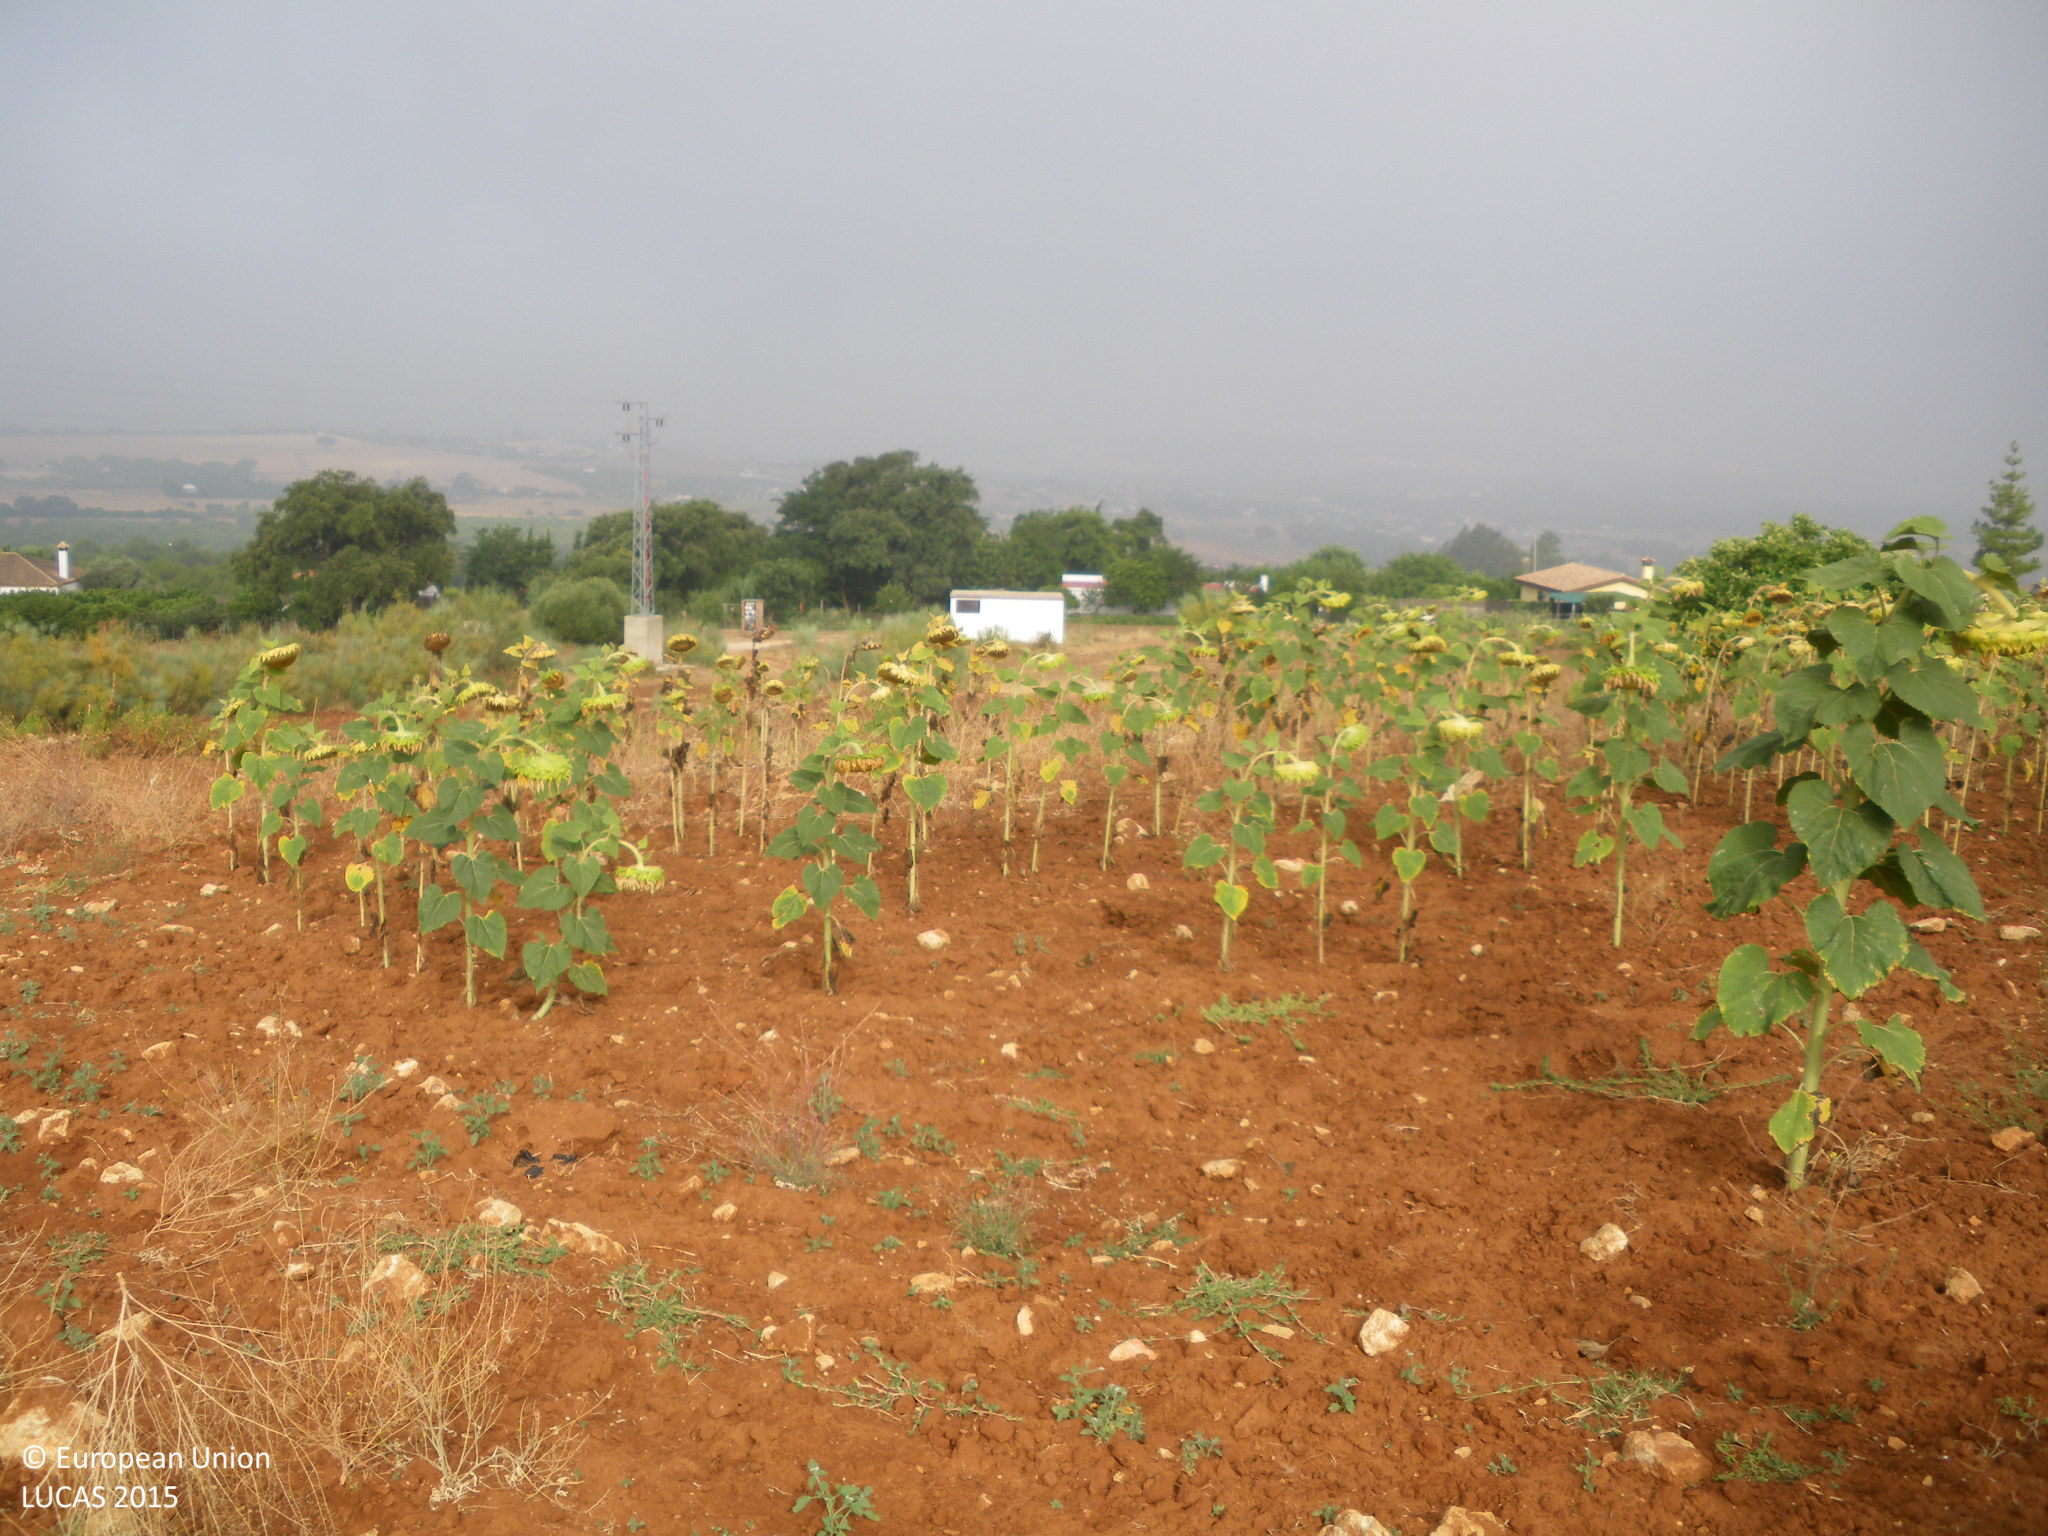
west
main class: Cropland
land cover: Sunflower
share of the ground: < 10 %
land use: Agriculture (excluding fallow land and kitchen gardens)
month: July
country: ES
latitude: 36.7409
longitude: -5.7420
